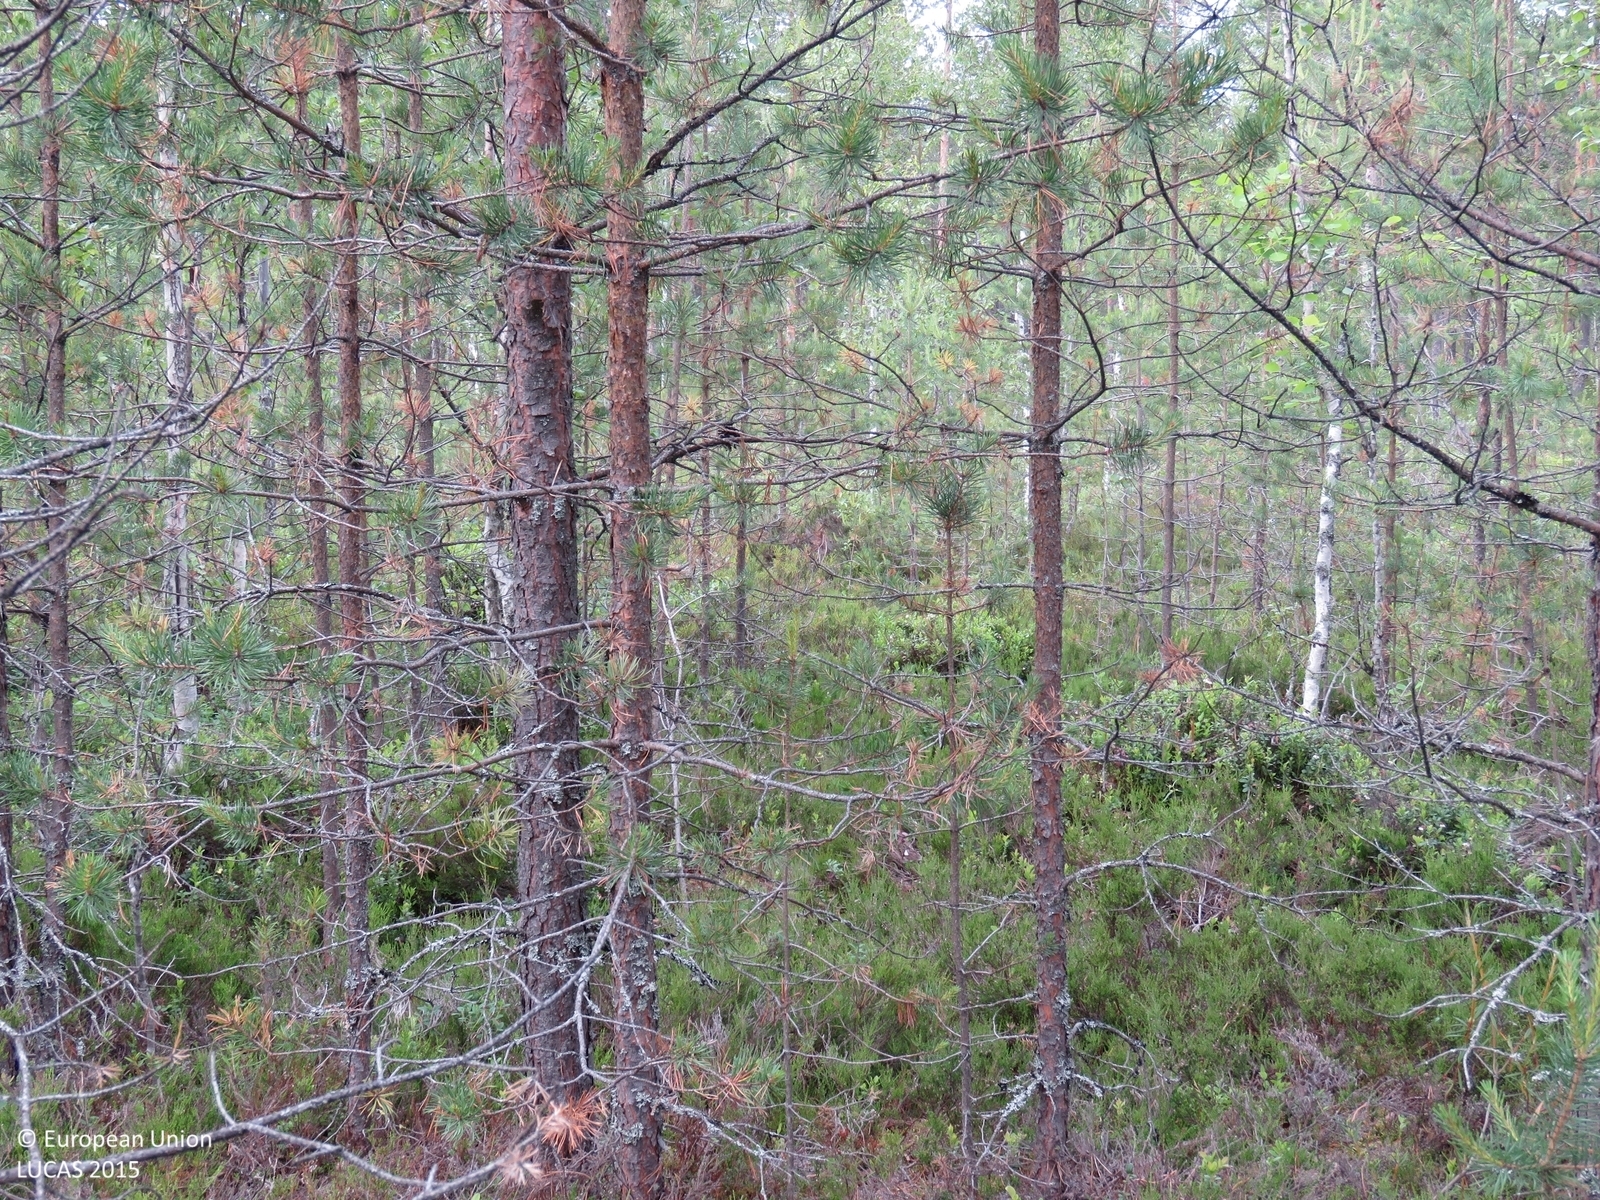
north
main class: Woodland
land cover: Pine dominated mixed woodland
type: boreal forest
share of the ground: > 75 %
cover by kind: coniferous forest trees 45 %, broadleaved forest trees 35 %, shrubs 10 %, herbaceous plants 5 %, lichens and mosses 5 %
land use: Forestry
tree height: > 5 m
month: July
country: FI
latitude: 64.4813
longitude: 26.4019
